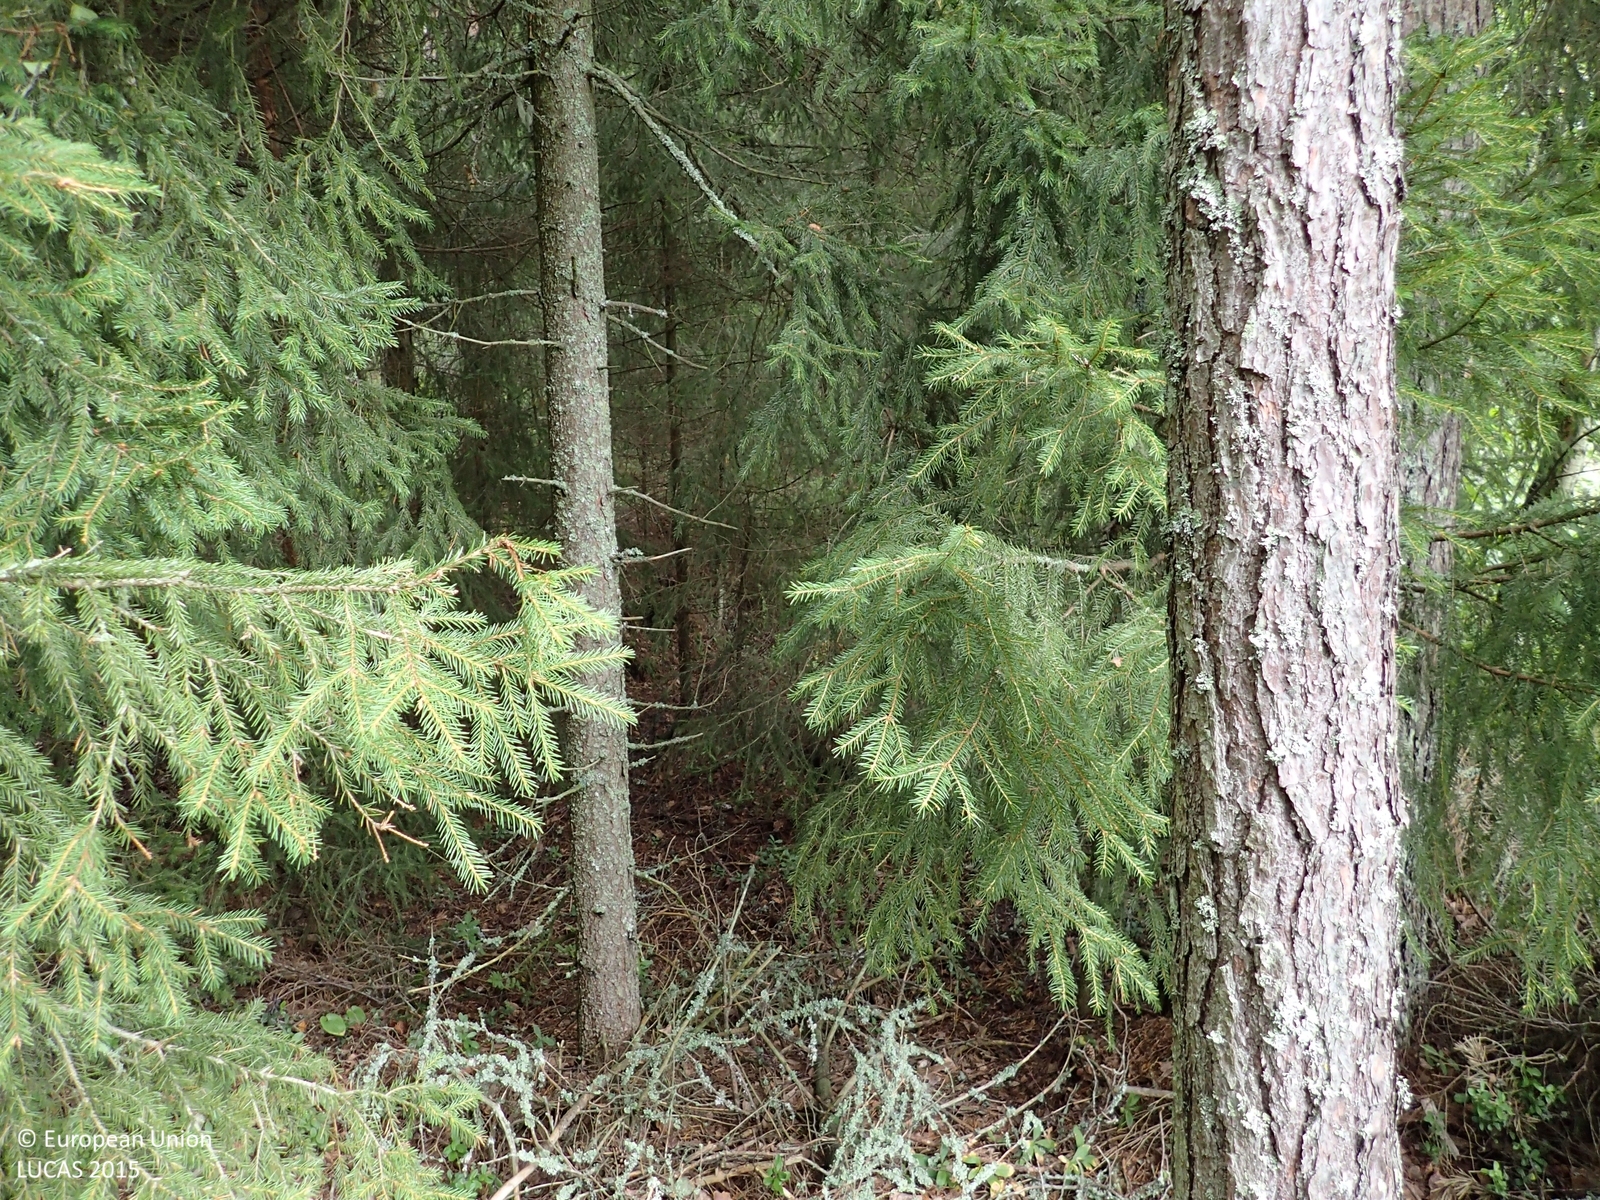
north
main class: Woodland
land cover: Other mixed woodland
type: boreal forest
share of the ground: > 75 %
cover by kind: coniferous forest trees 60 %, broadleaved forest trees 20 %, shrubs 20 %
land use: Forestry
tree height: > 5 m
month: August
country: FI
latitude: 62.9169
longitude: 21.9963
